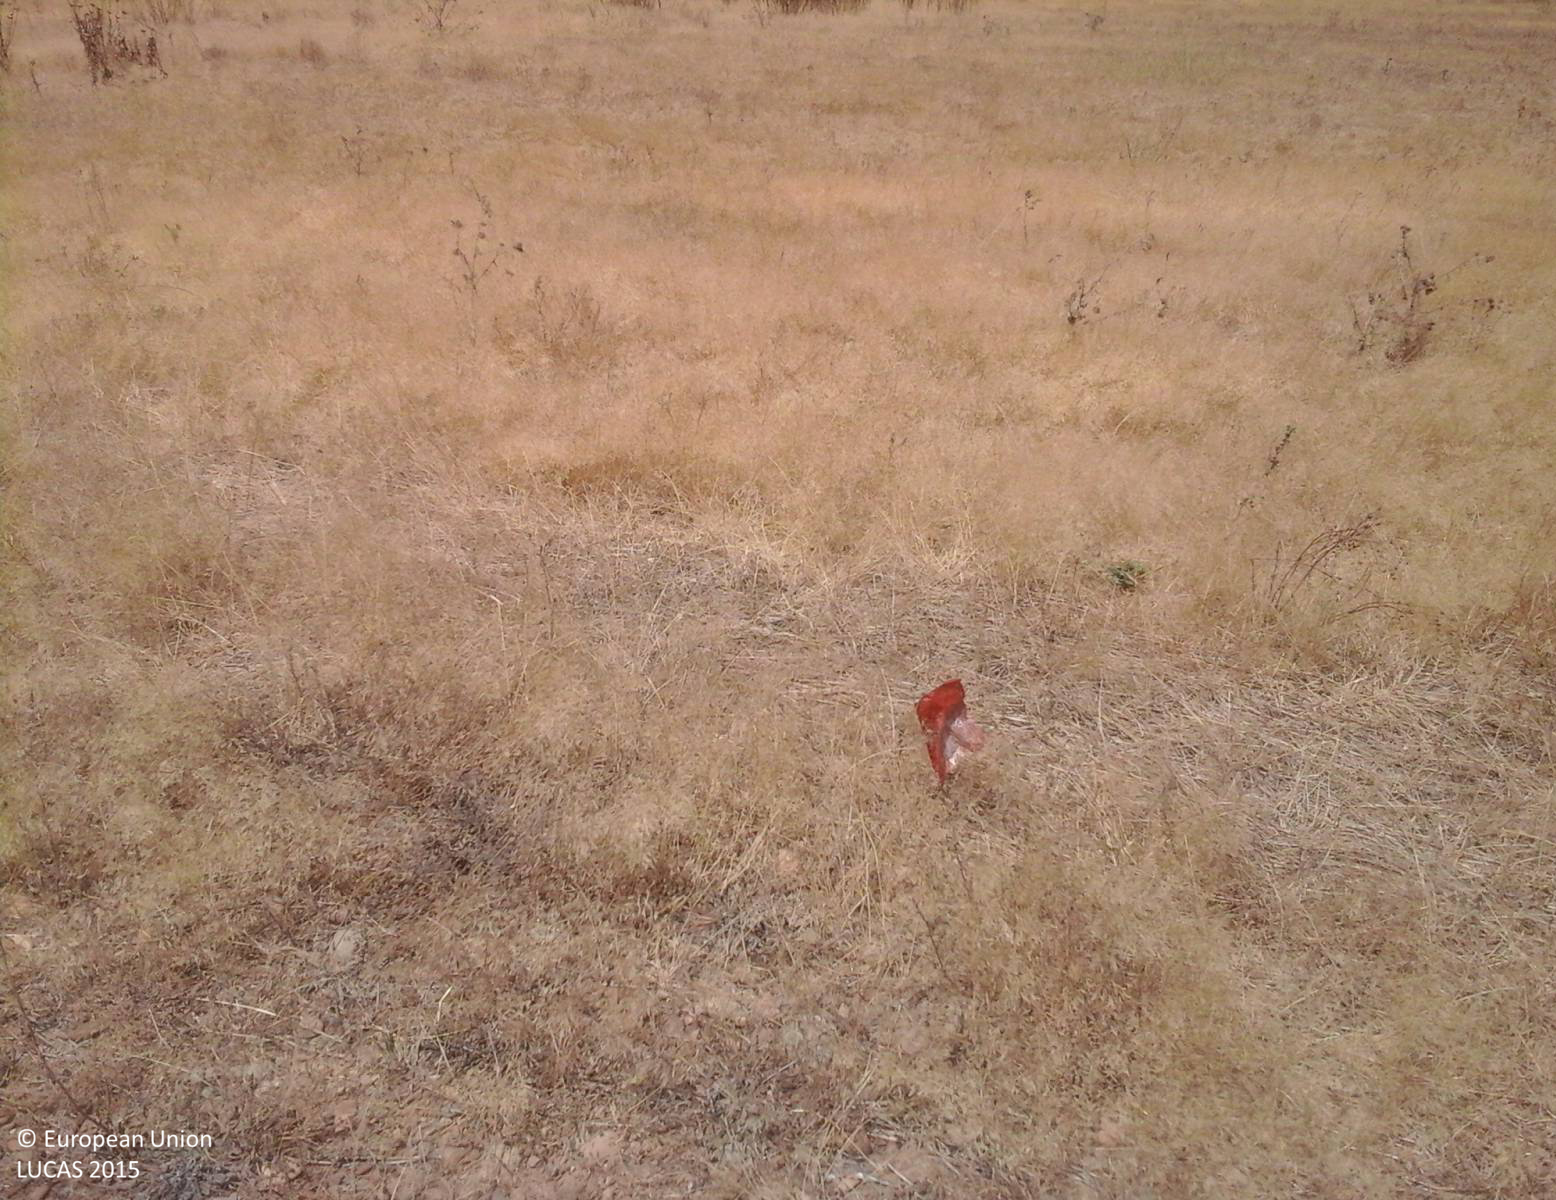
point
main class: Cropland
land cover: Mixed cereals for fodder
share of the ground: > 75 %
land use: Agriculture (excluding fallow land and kitchen gardens)
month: August
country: IT
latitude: 39.4459
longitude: 8.8796
